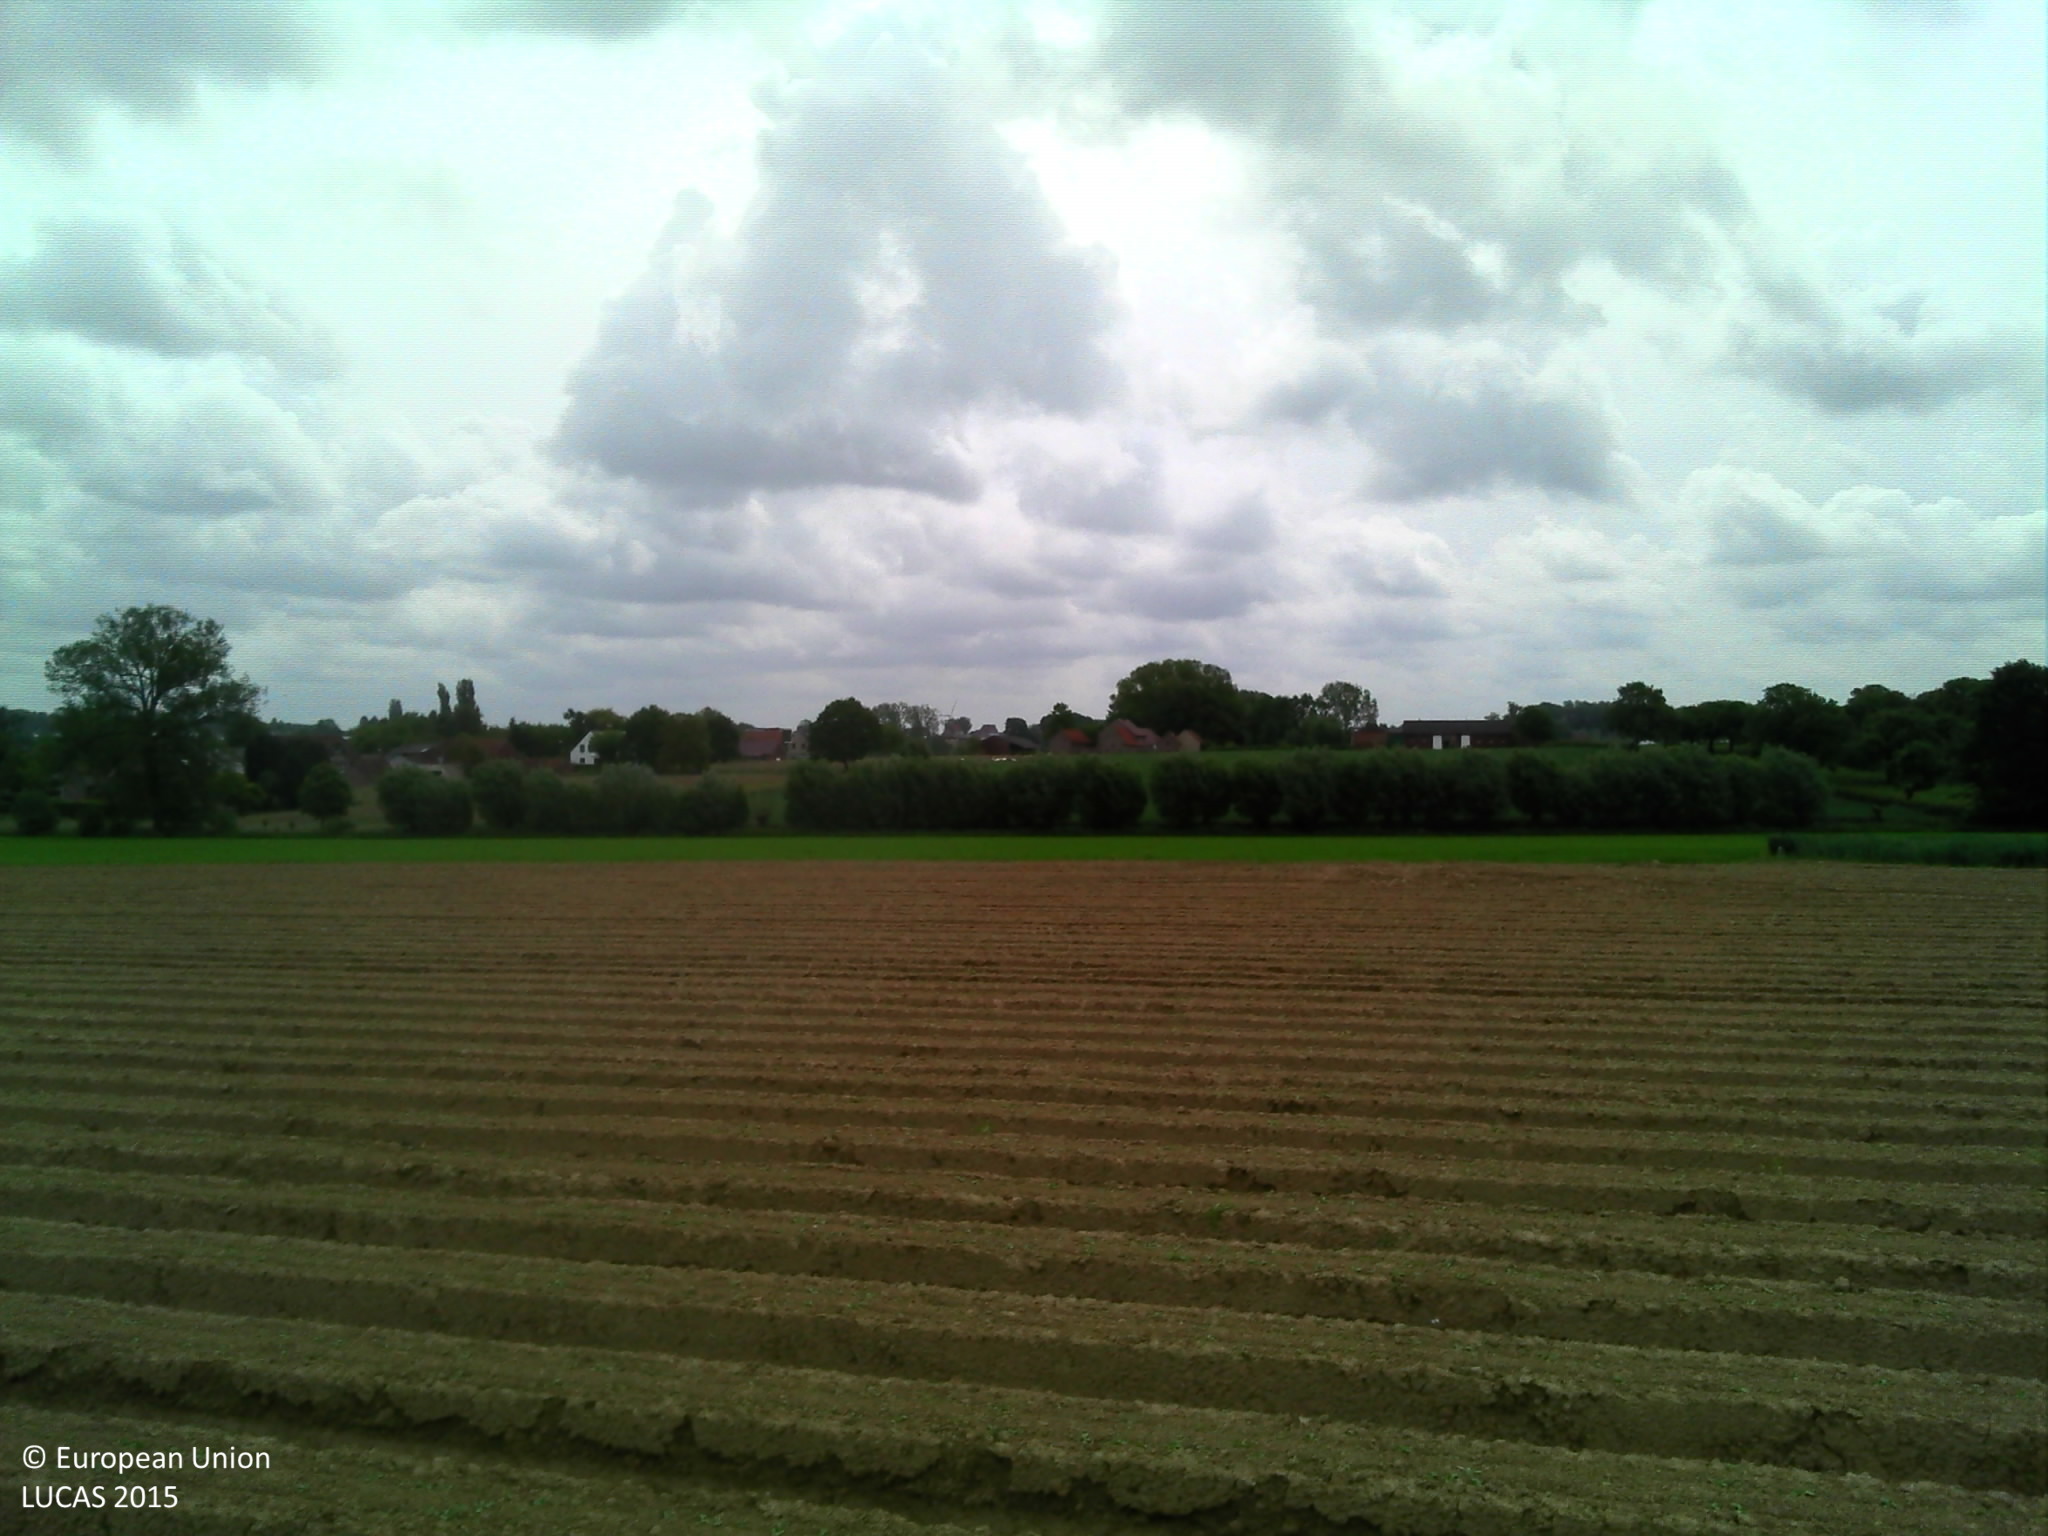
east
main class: Cropland
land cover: Other fresh vegetables
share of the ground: < 10 %
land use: Agriculture (excluding fallow land and kitchen gardens)
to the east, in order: Other fresh vegetables; Sugar beet; Grass margins; Rivers and streams; Lines of trees; Grass margins; Common wheat
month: May
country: BE
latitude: 50.7368
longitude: 4.1427
